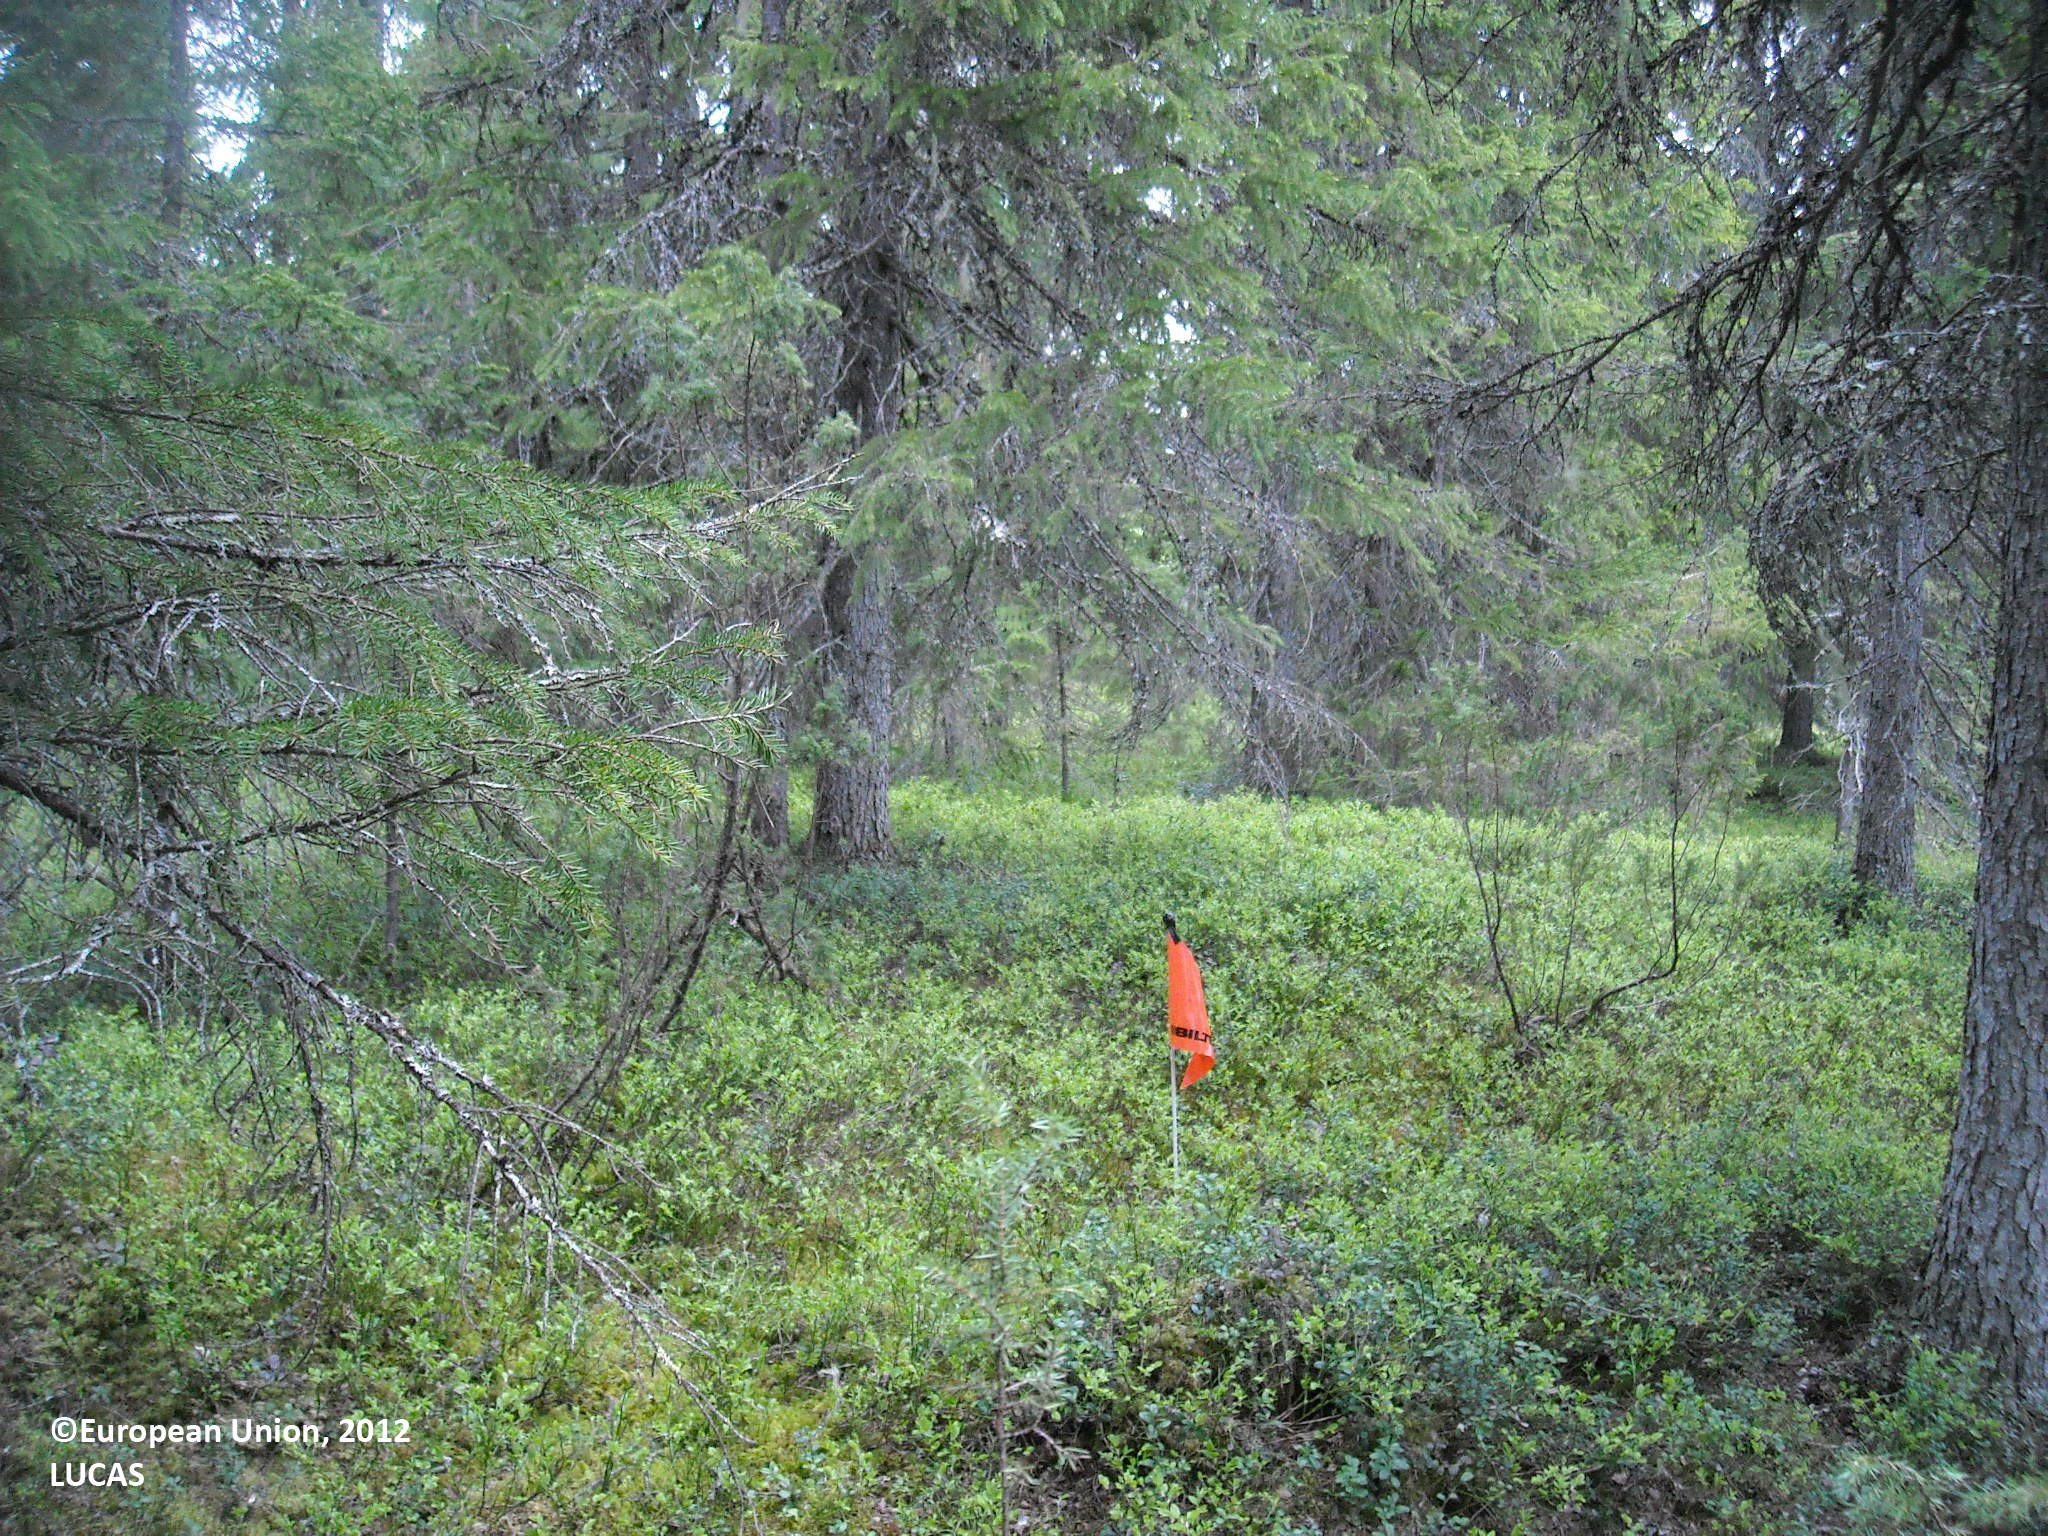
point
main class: Woodland
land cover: Spruce dominated coniferous woodland
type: boreal forest
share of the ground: > 75 %
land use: Forestry
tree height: > 5 m
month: June
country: FI
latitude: 65.3166
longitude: 27.8036
